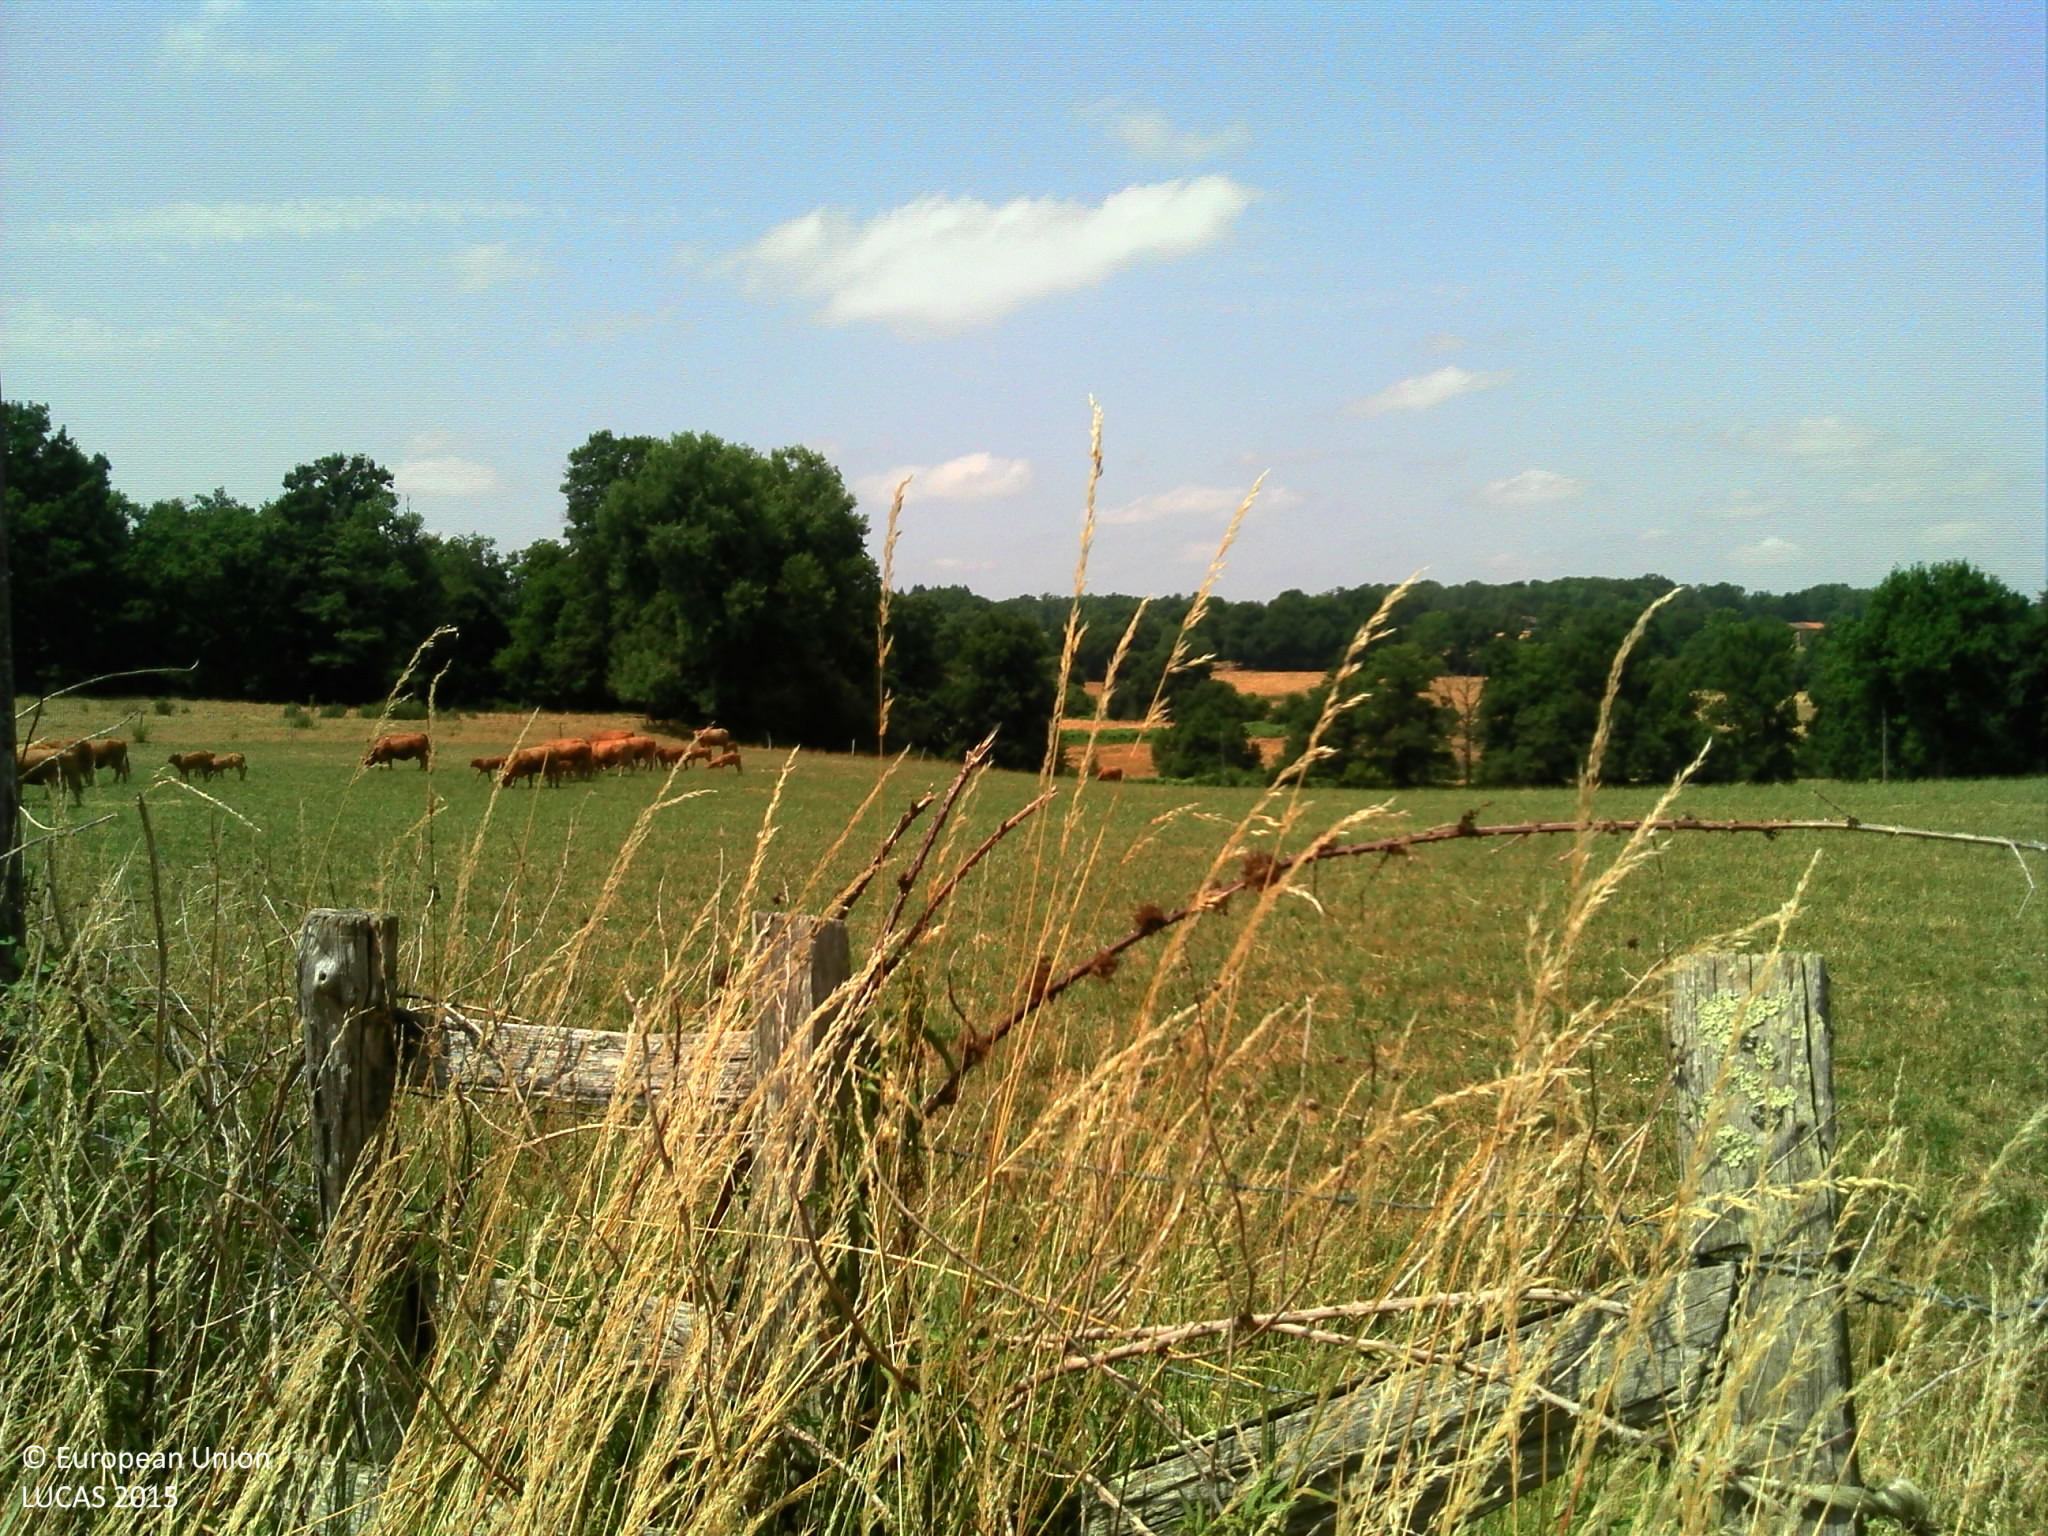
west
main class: Grassland
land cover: Grassland without tree/shrub cover
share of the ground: > 75 %
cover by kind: herbaceous plants 95 %
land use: Agriculture (excluding fallow land and kitchen gardens)
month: July
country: FR
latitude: 45.7340
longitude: 0.9809
